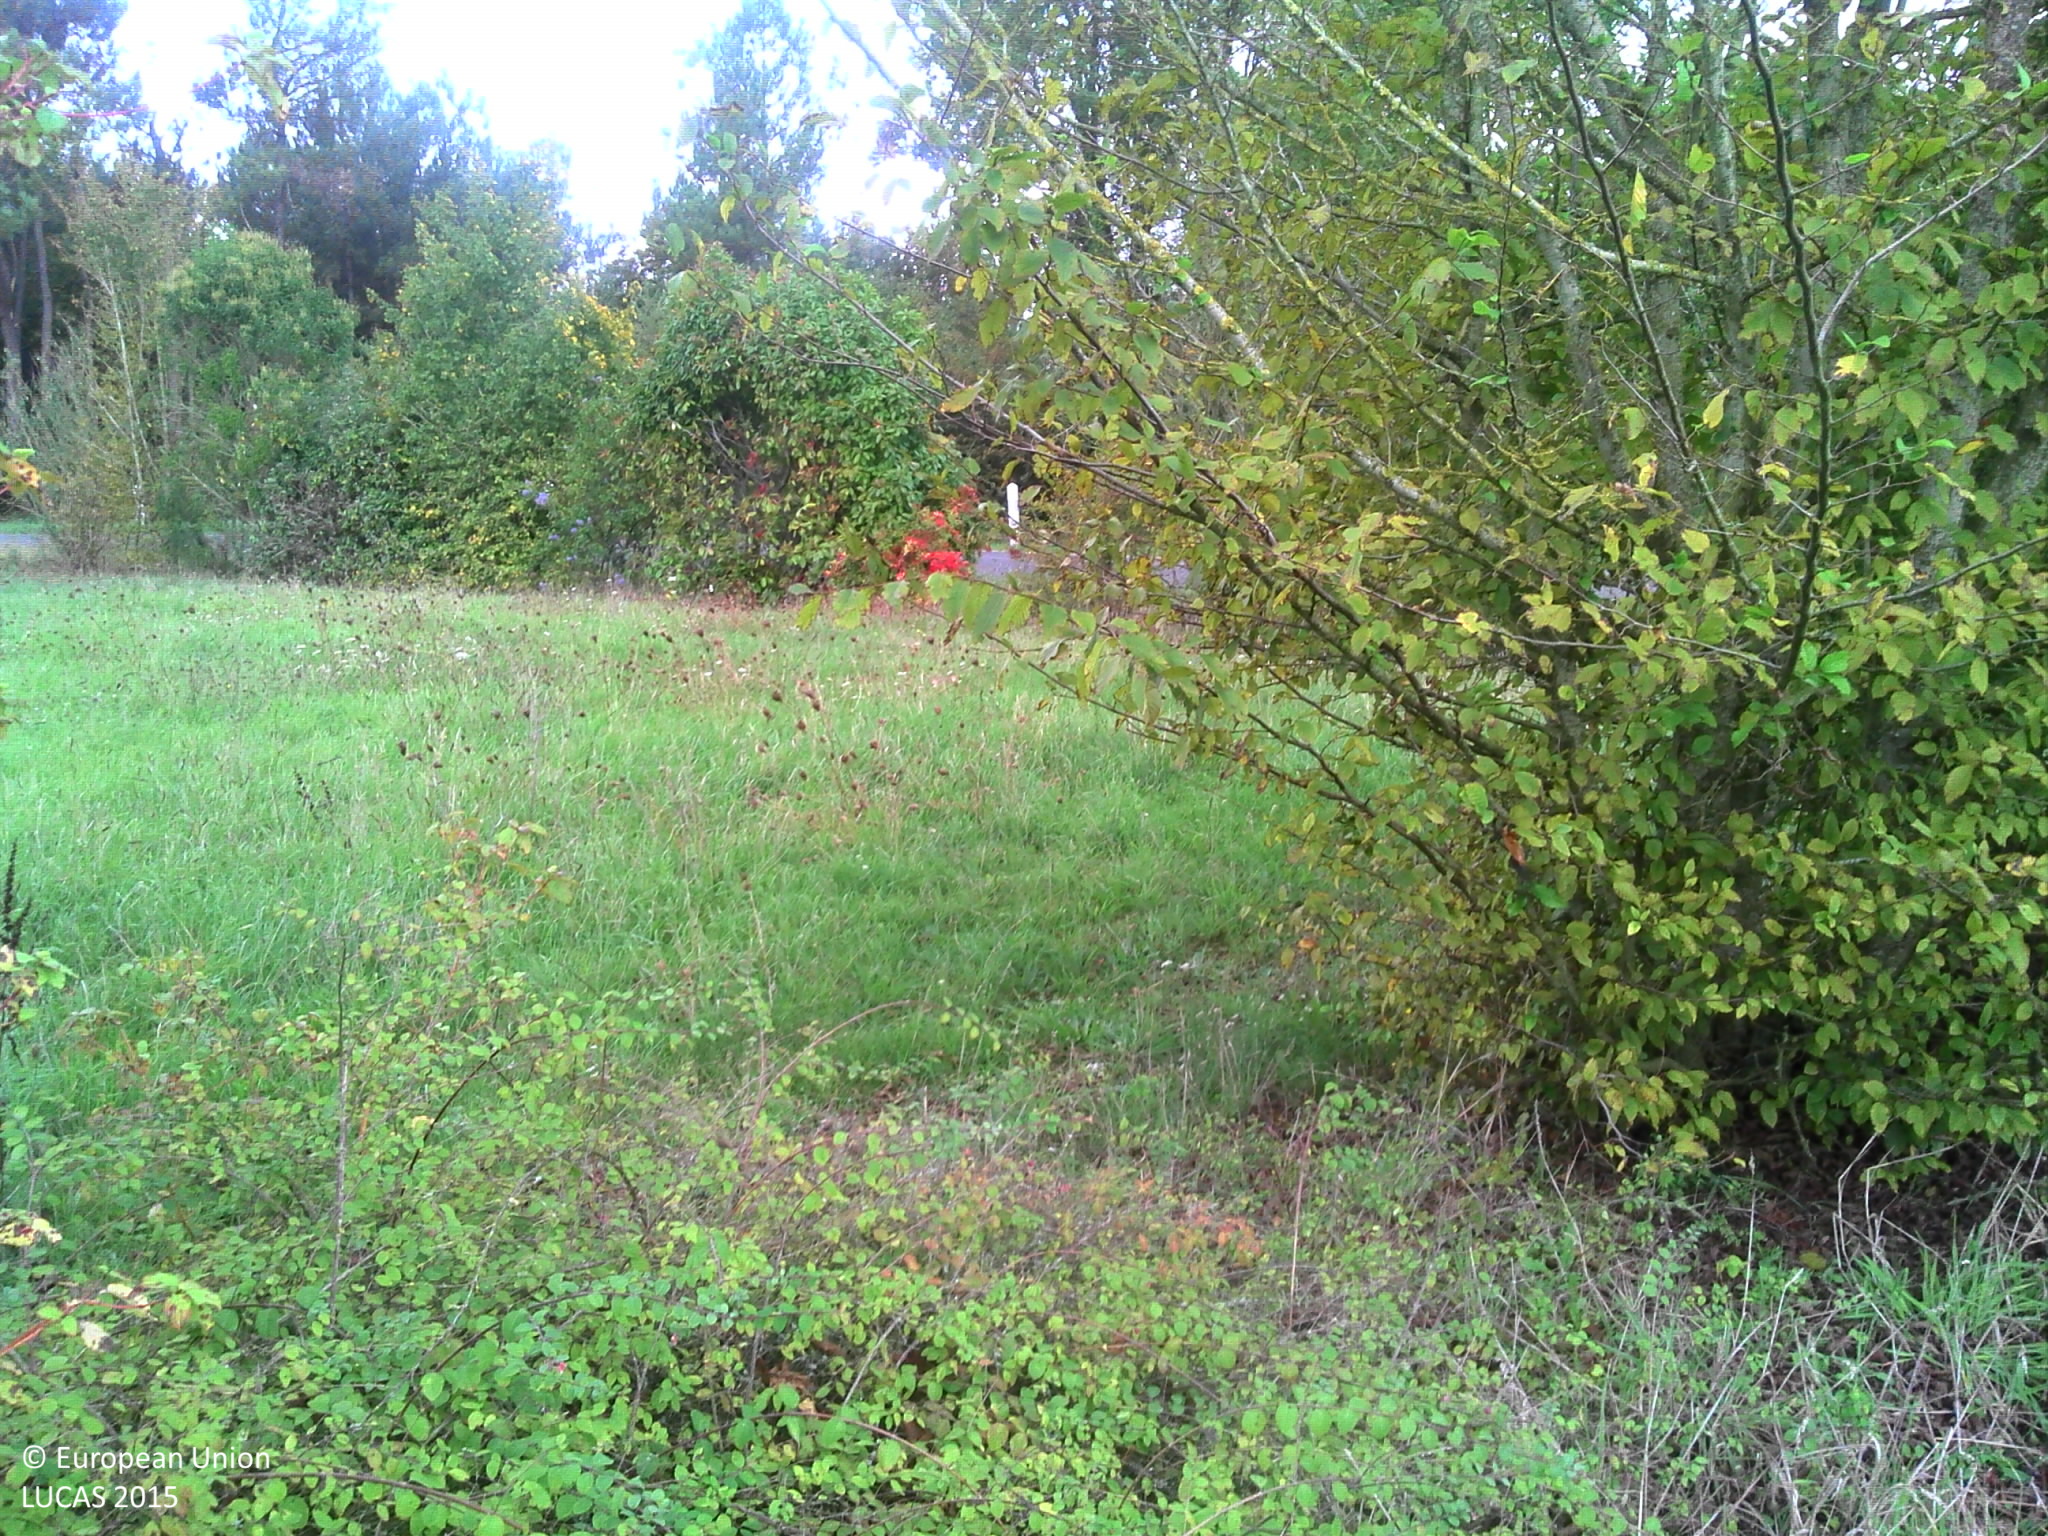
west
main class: Grassland
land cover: Grassland without tree/shrub cover
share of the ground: > 75 %
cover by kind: herbaceous plants 100 %
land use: Agriculture (excluding fallow land and kitchen gardens)
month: October
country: FR
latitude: 46.9745
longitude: 0.4501
